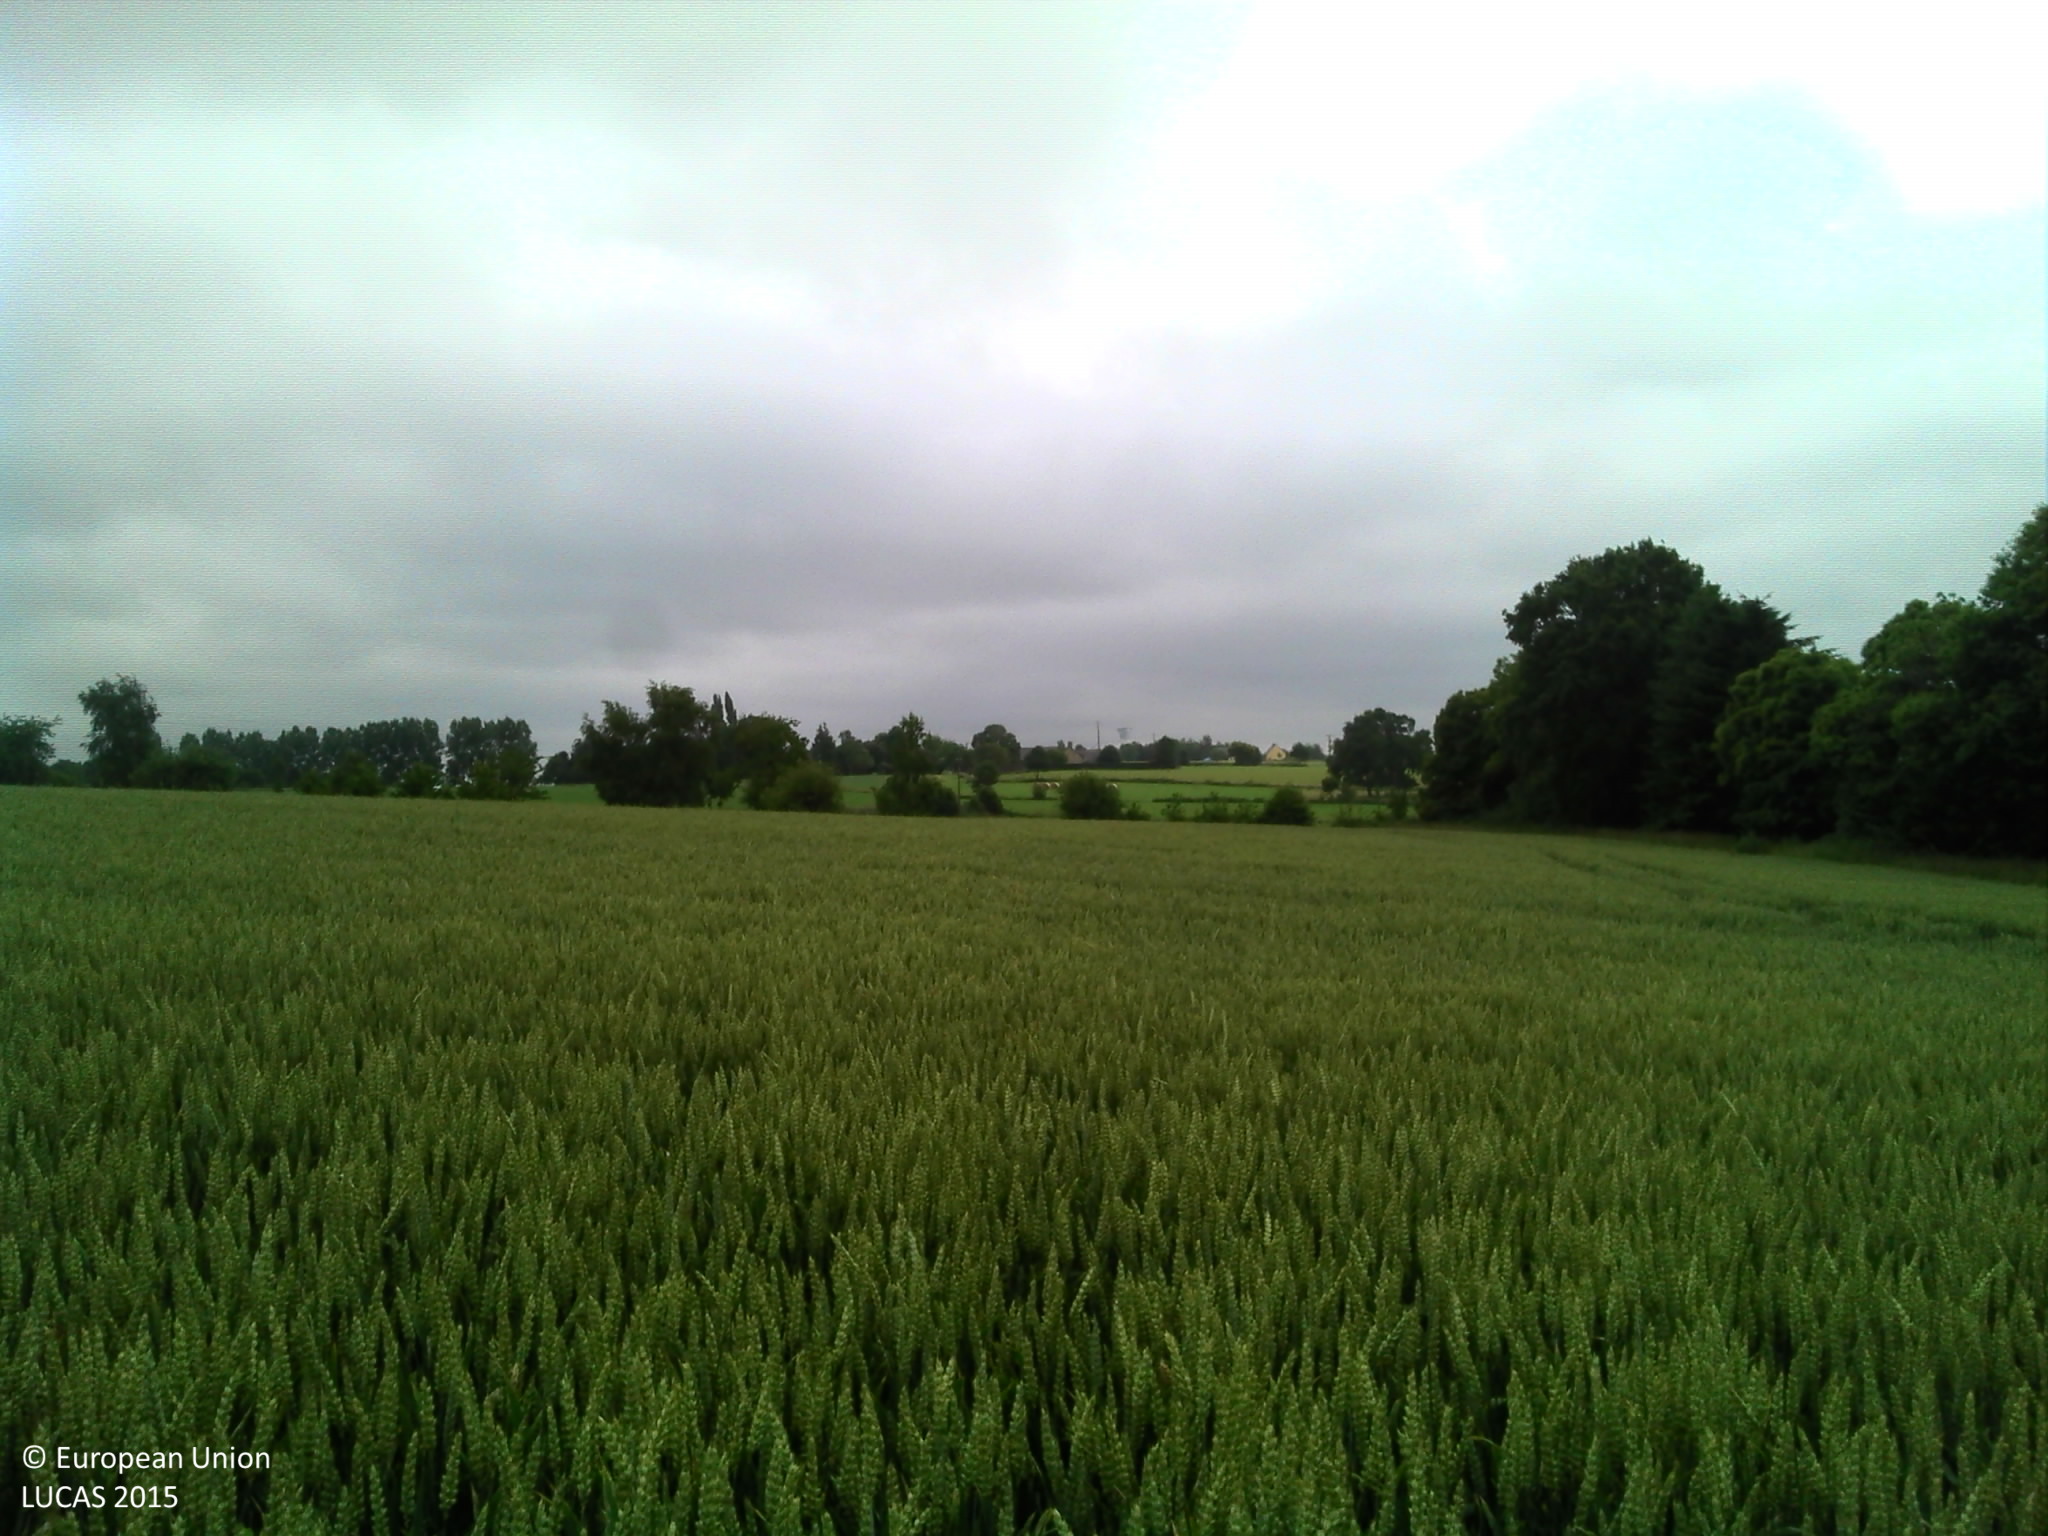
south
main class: Cropland
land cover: Common wheat
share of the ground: > 75 %
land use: Agriculture (excluding fallow land and kitchen gardens)
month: June
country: FR
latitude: 48.3001
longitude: -1.2456
